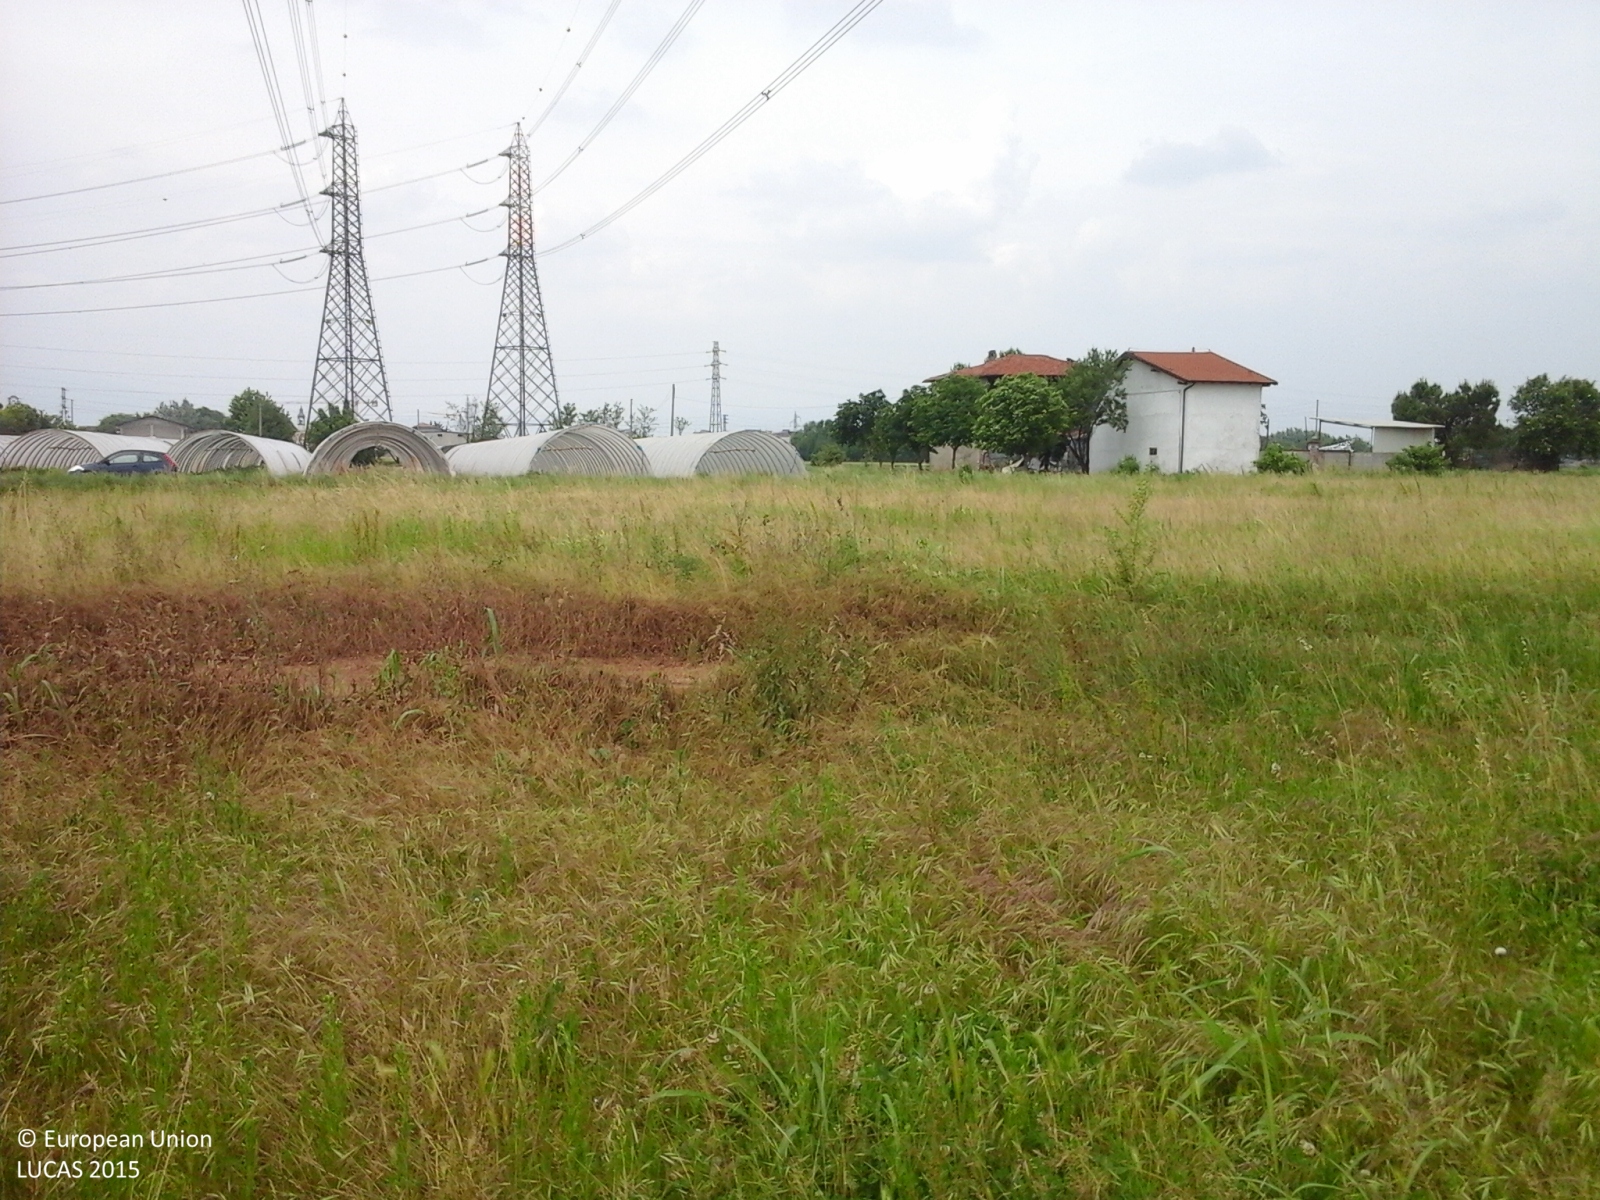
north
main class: Artificial land
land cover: Other artificial areas
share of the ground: > 75 %
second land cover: Spontaneously vegetated surfaces
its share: > 75 %
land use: Electricity, gas and thermal power distribution
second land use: Sport
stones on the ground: > 50 %
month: May
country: IT
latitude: 45.5757
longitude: 9.6034
